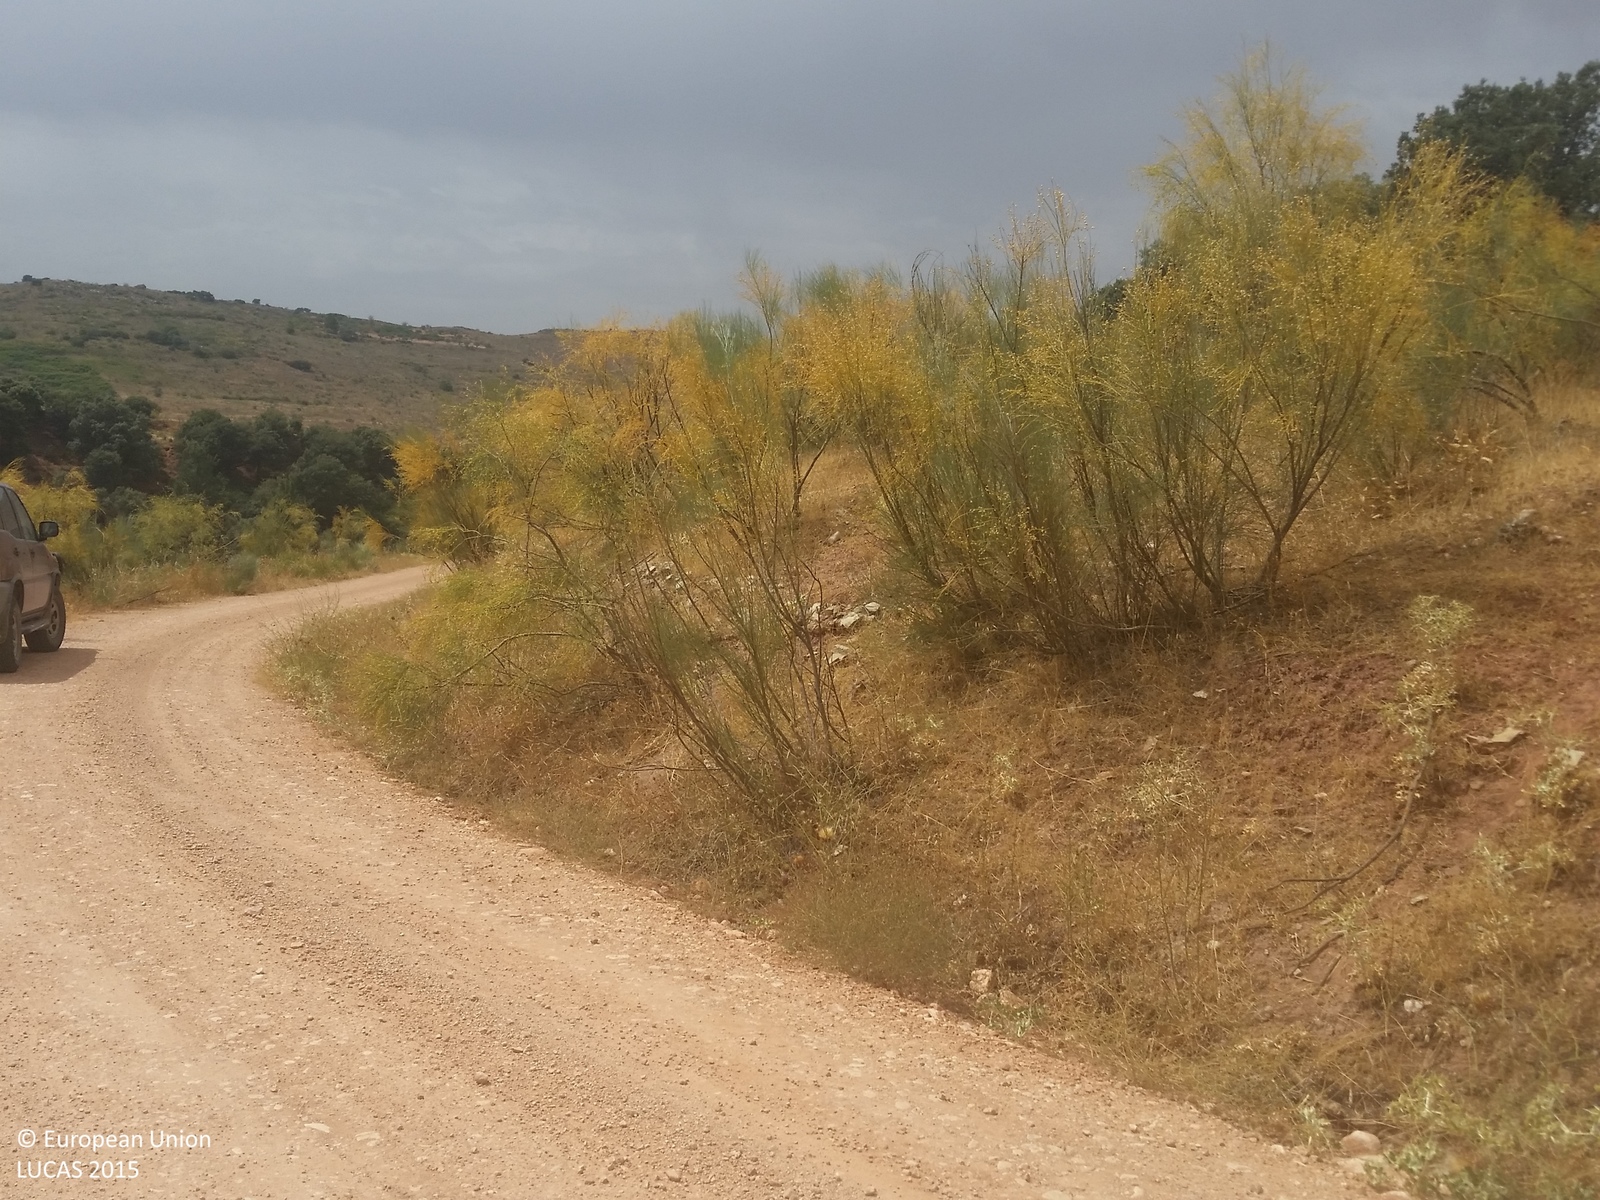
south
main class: Woodland
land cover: Broadleaved woodland
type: acidophilous oak and oak-birch forest
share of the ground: 50 - 75 %
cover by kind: broadleaved forest trees 50 %, shrubs 20 %, herbaceous plants 15 %, consolidated bare surface 15 %
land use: Semi-natural and natural areas not in use
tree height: < 5 m
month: August
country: ES
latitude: 38.6812
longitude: -2.4736
